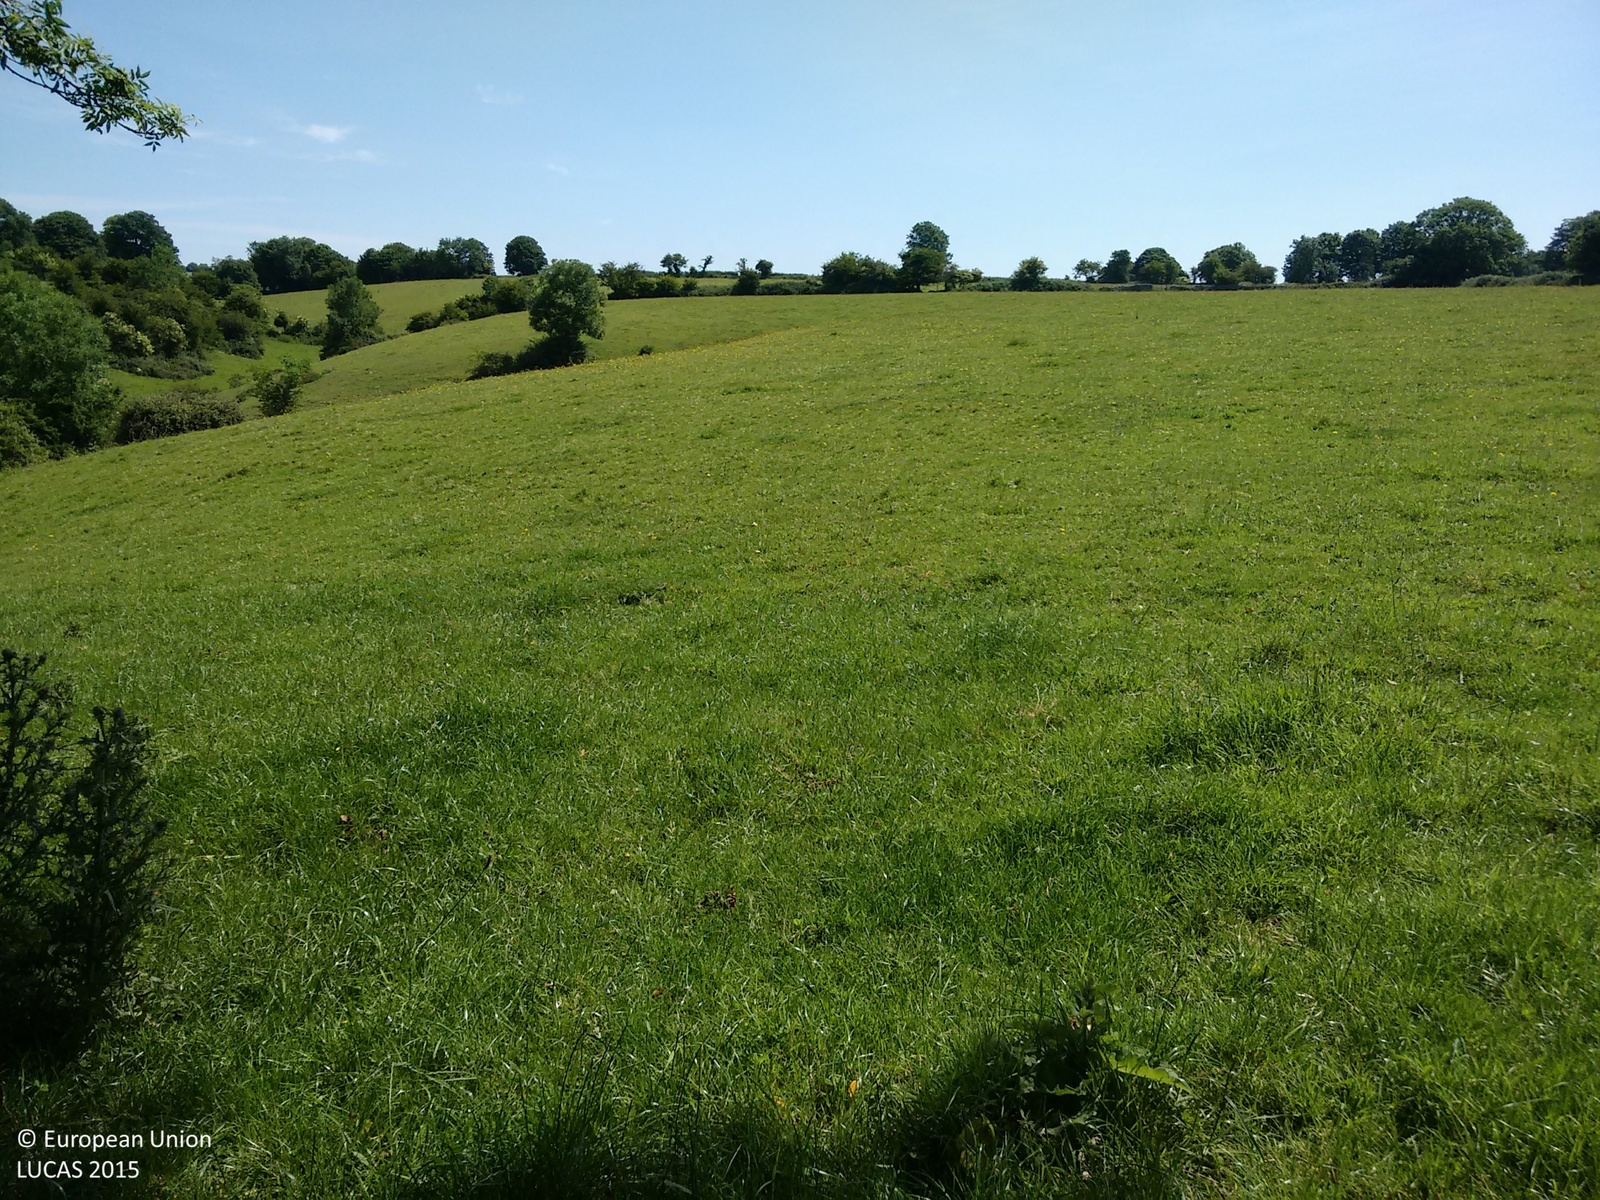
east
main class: Grassland
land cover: Grassland without tree/shrub cover
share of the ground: > 75 %
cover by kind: herbaceous plants 100 %
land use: Energy production
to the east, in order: Artificial constructions in urban areas; Grassland without tree/shrub cover; Abandoned hedges; Fences; Abandoned hedges; Grassland without tree/shrub cover; Abandoned hedges; Fences; Dry stone walls; Fences; Abandoned hedges; Grassland without tree/shrub cover; Single bushes/trees; Grassland without tree/shrub cover
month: July
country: GB
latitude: 51.2004
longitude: -2.5323
